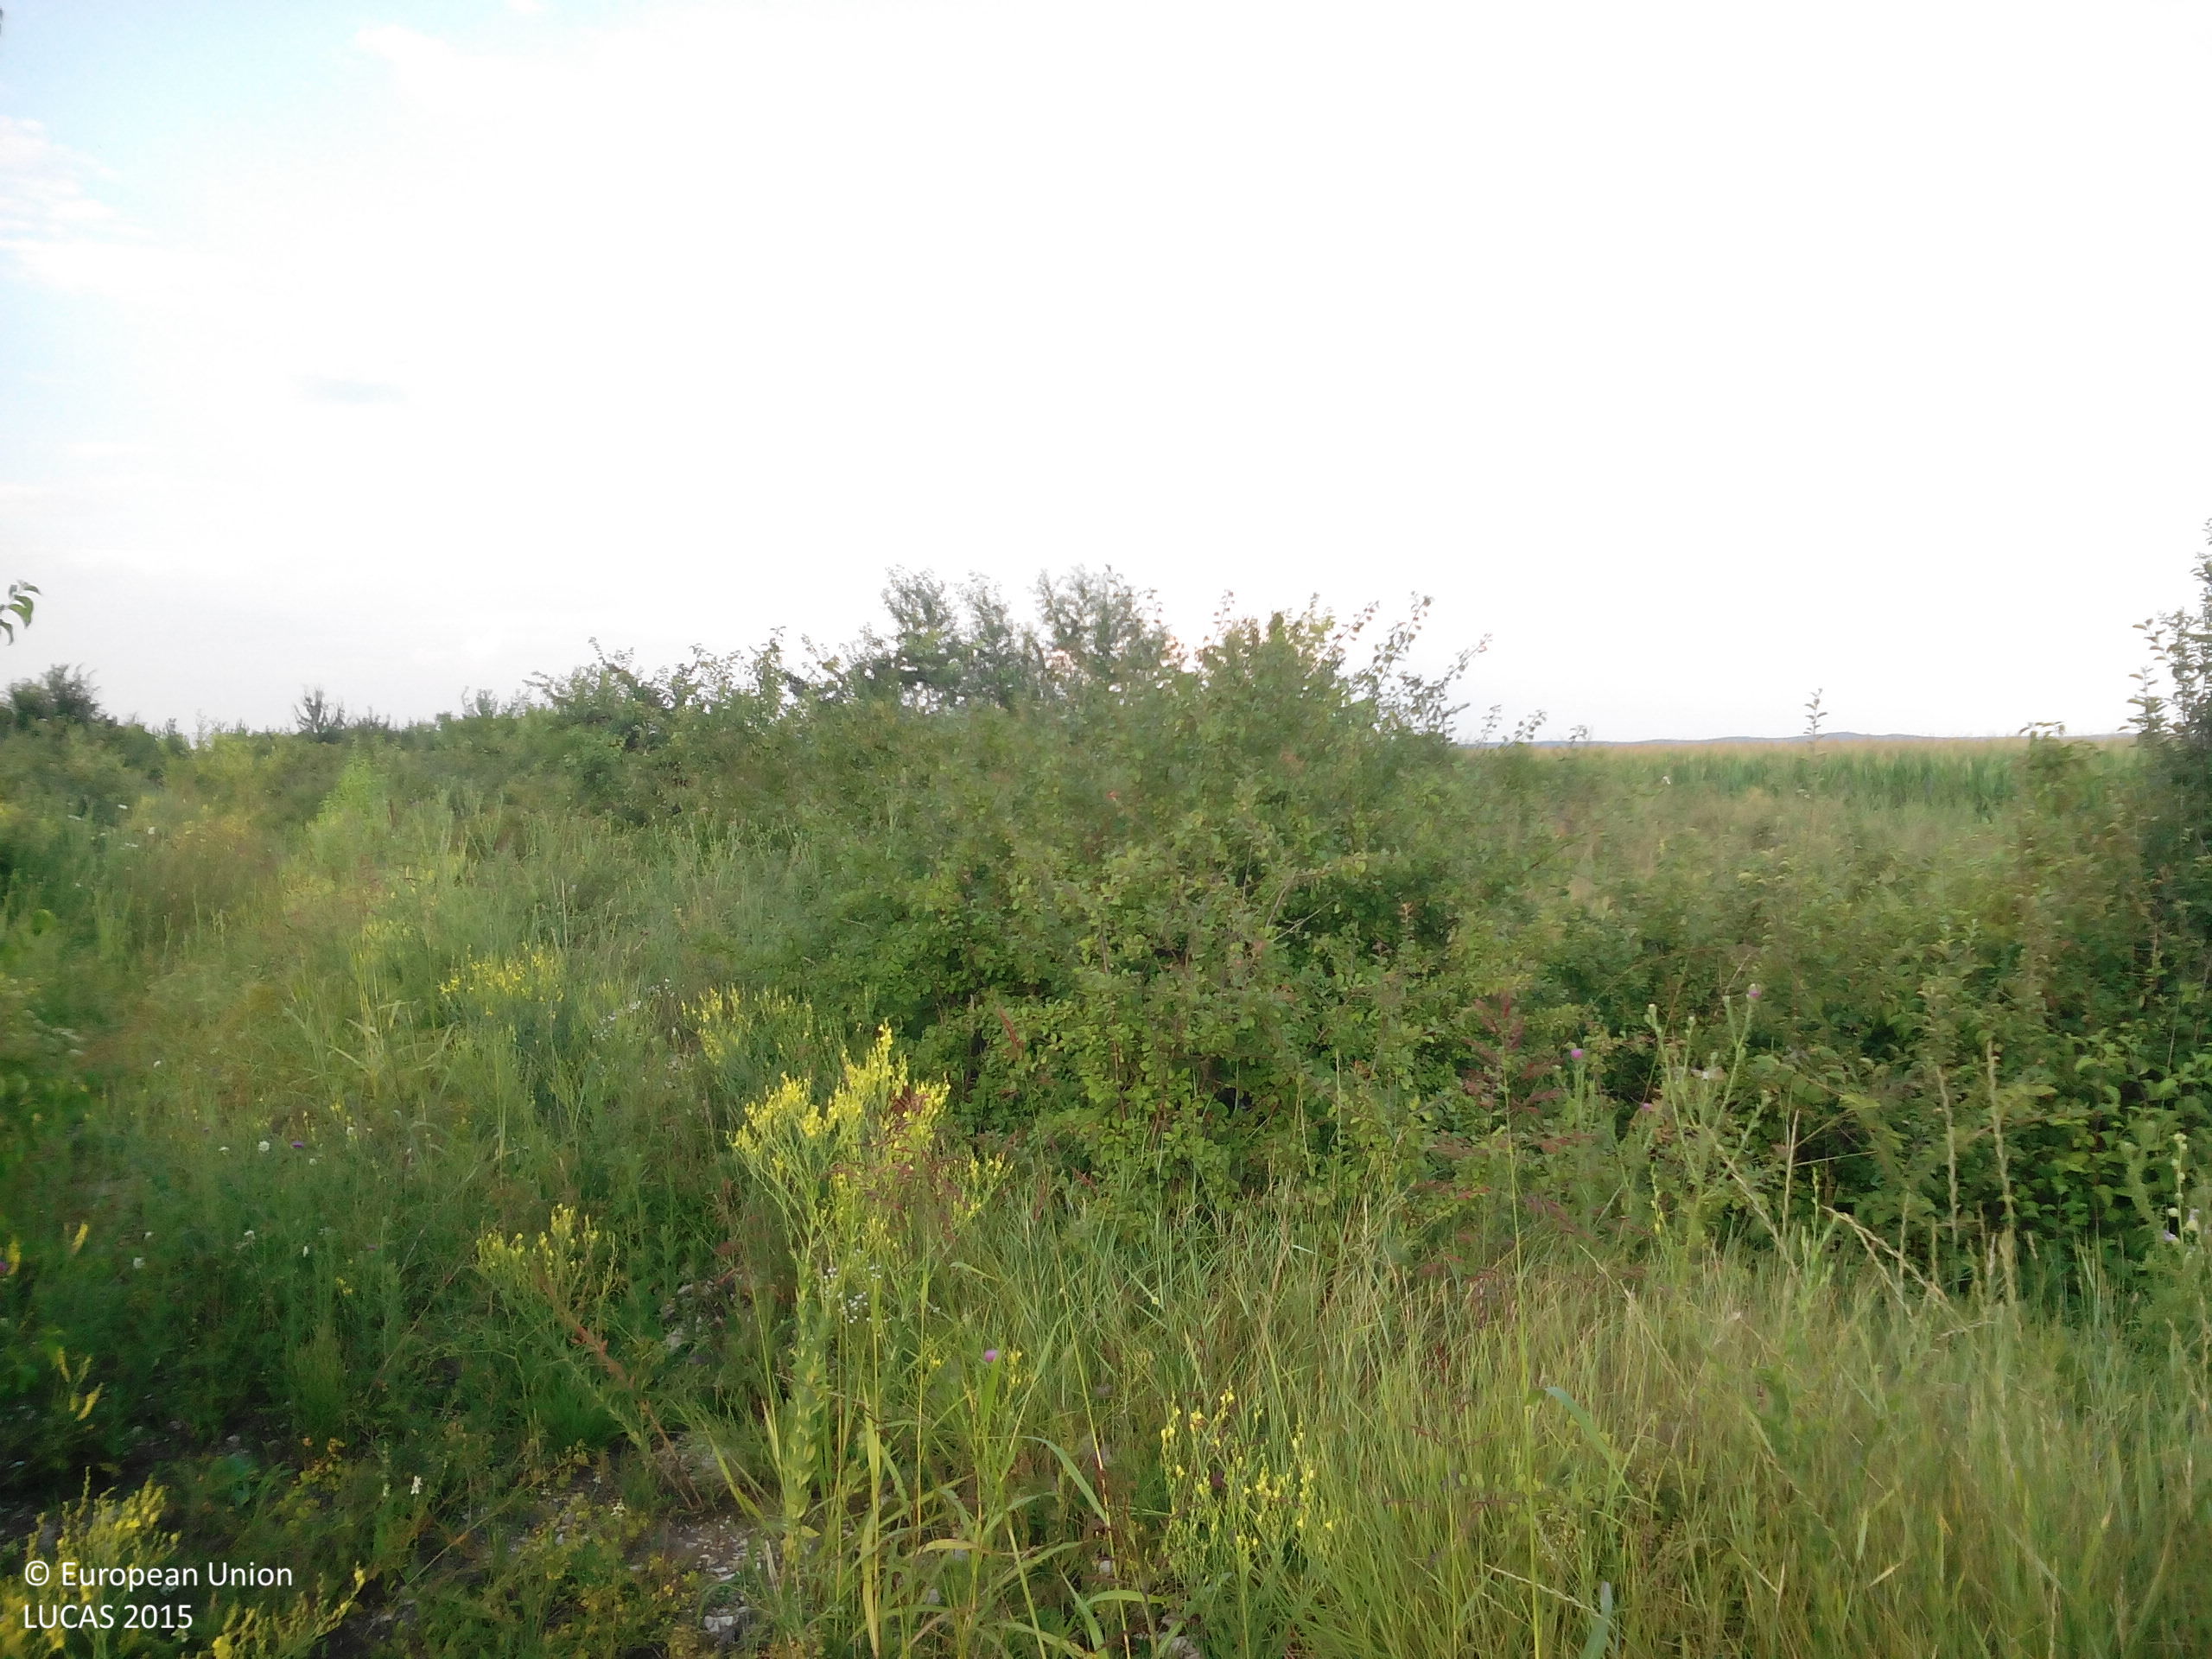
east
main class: Shrubland
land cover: Shrubland with sparse tree cover
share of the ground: > 75 %
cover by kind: shrubs 90 %, broadleaved forest trees 5 %, herbaceous plants 5 %
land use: Abandoned areas
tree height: < 5 m
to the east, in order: Shrubland with sparse tree cover; Ditches and canals; Shrubland with sparse tree cover; Ditches and canals; Shrubland with sparse tree cover; Maize
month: July
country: BG
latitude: 43.3451
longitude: 24.1037
